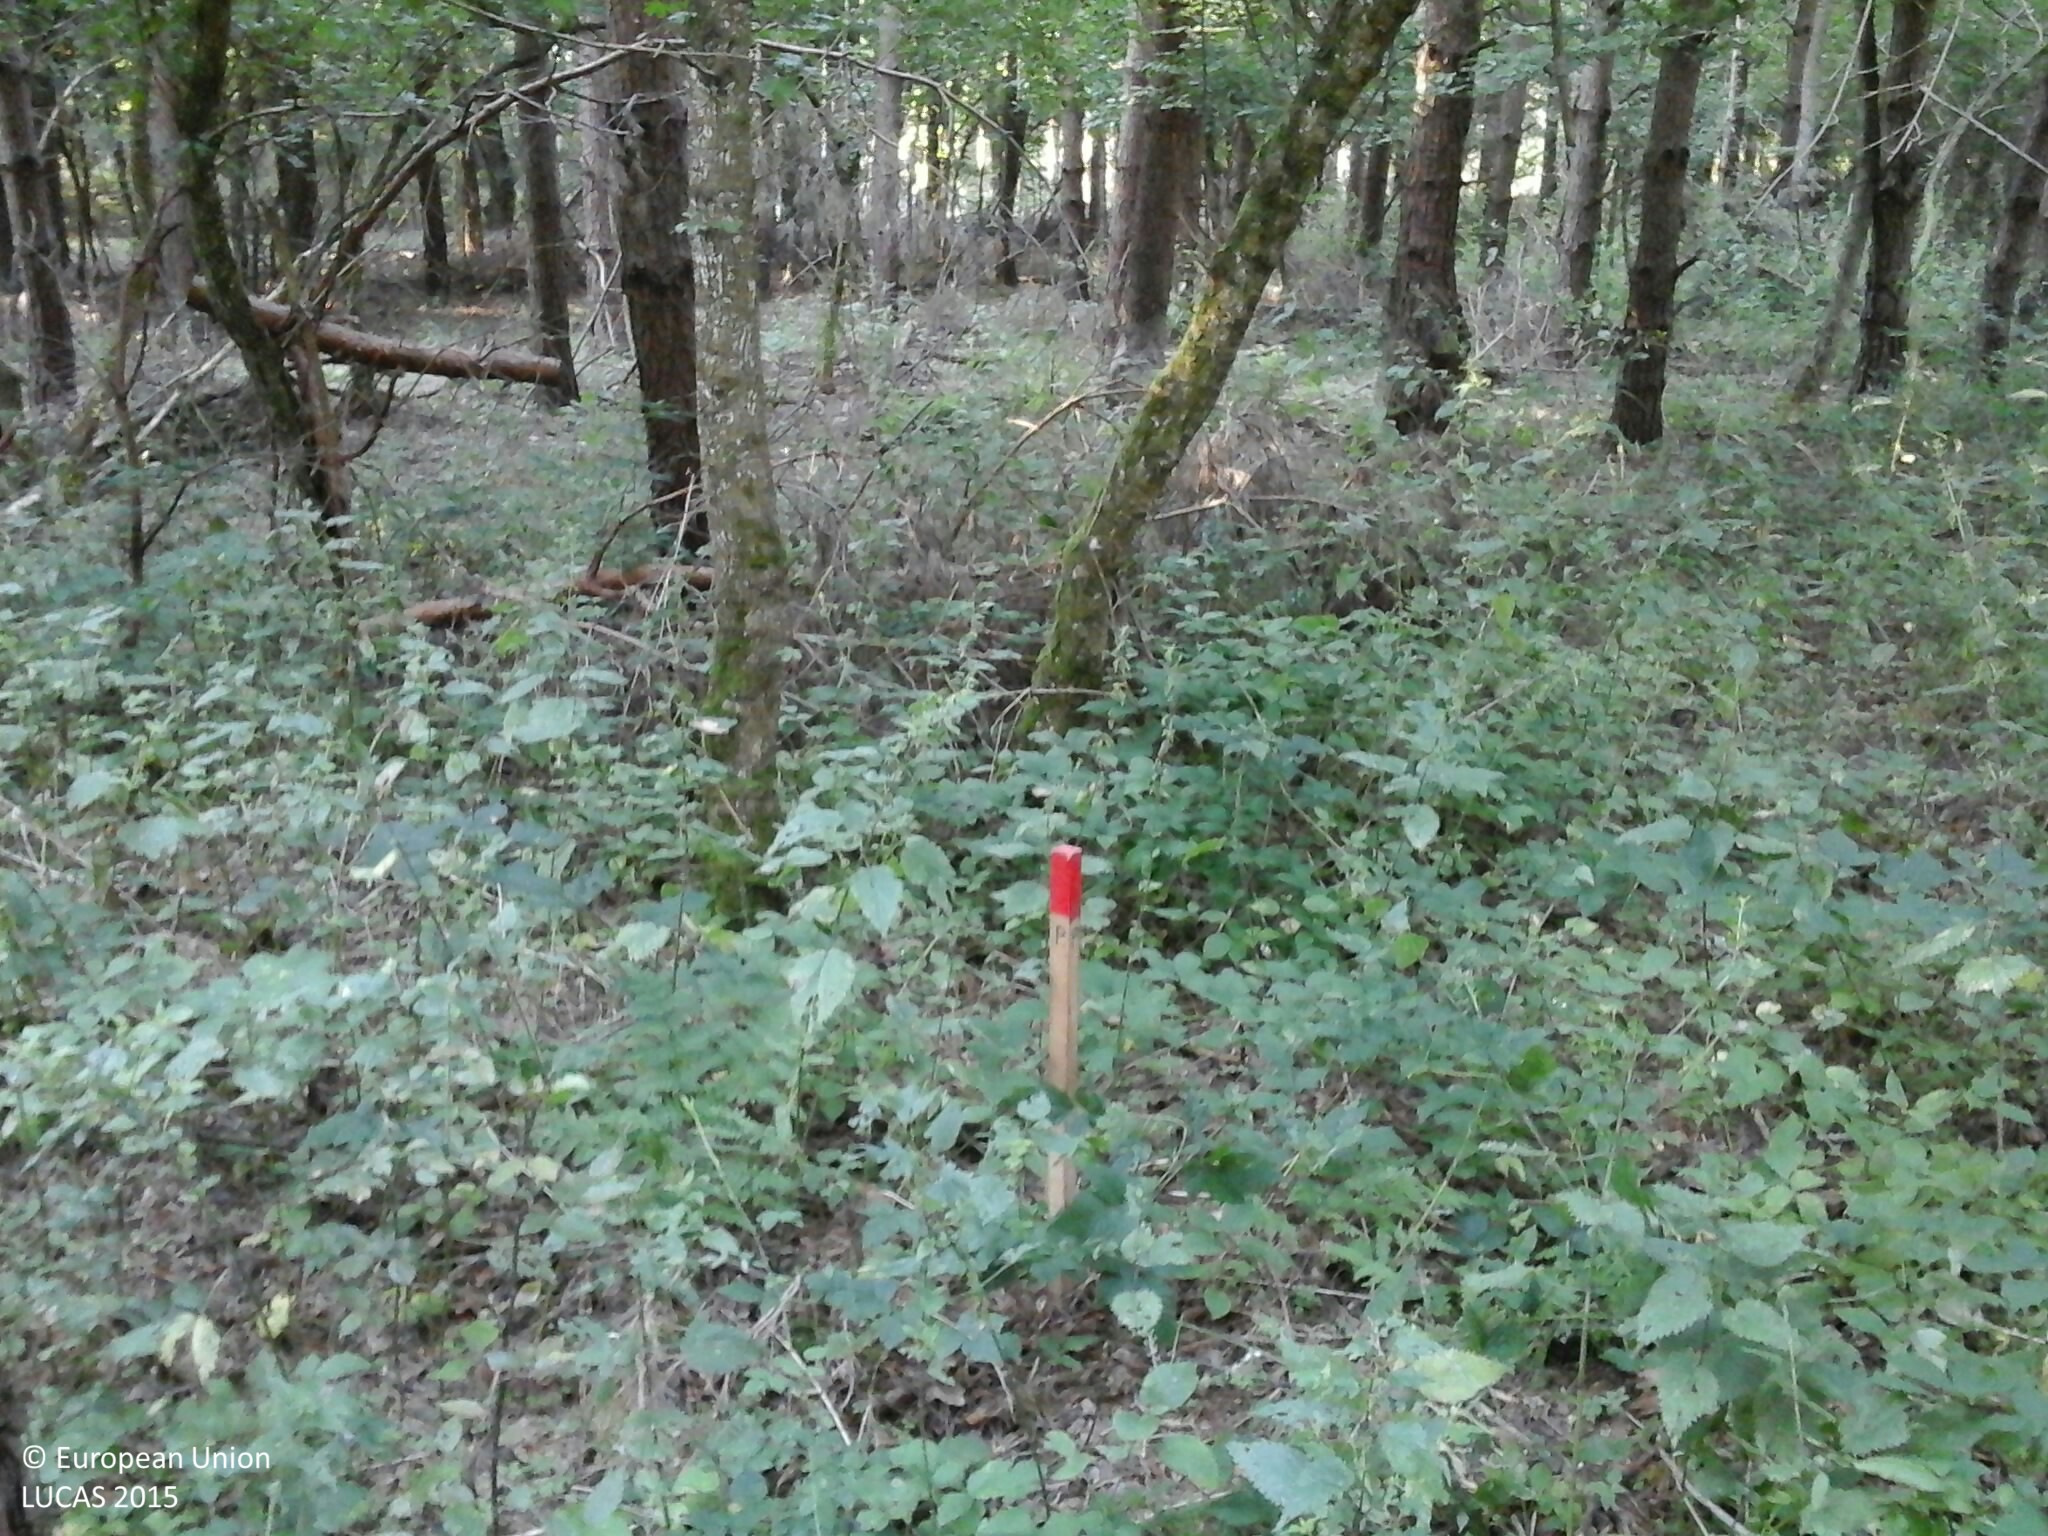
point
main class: Woodland
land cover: Pine dominated mixed woodland
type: hemiboreal forest and nemoral coniferous forest and mixed broadleaved-coniferous forest
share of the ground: > 75 %
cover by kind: coniferous forest trees 60 %, broadleaved forest trees 20 %, shrubs 15 %, herbaceous plants 5 %
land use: Forestry
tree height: > 5 m
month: August
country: HU
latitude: 47.1662
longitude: 16.4802
